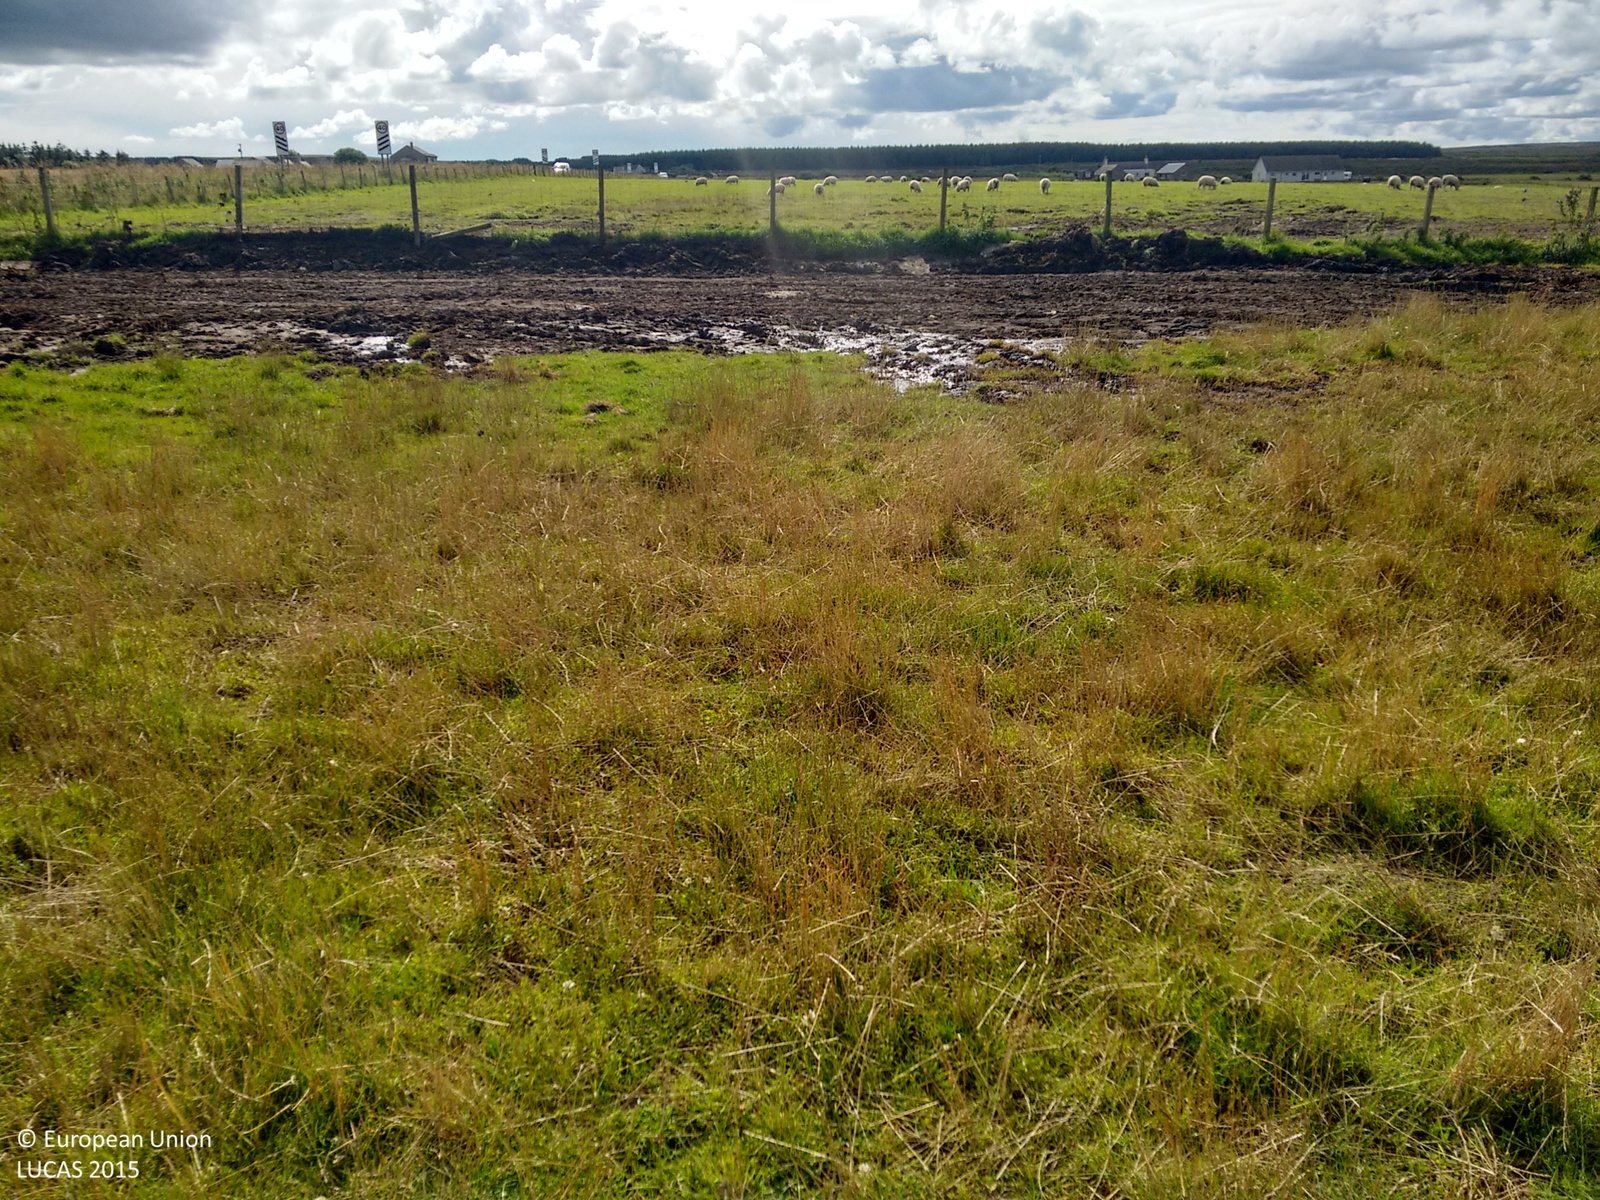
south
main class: Grassland
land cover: Grassland without tree/shrub cover
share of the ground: > 75 %
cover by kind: herbaceous plants 100 %
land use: Agriculture (excluding fallow land and kitchen gardens)
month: August
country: GB
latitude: 58.6388
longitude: -3.2378
